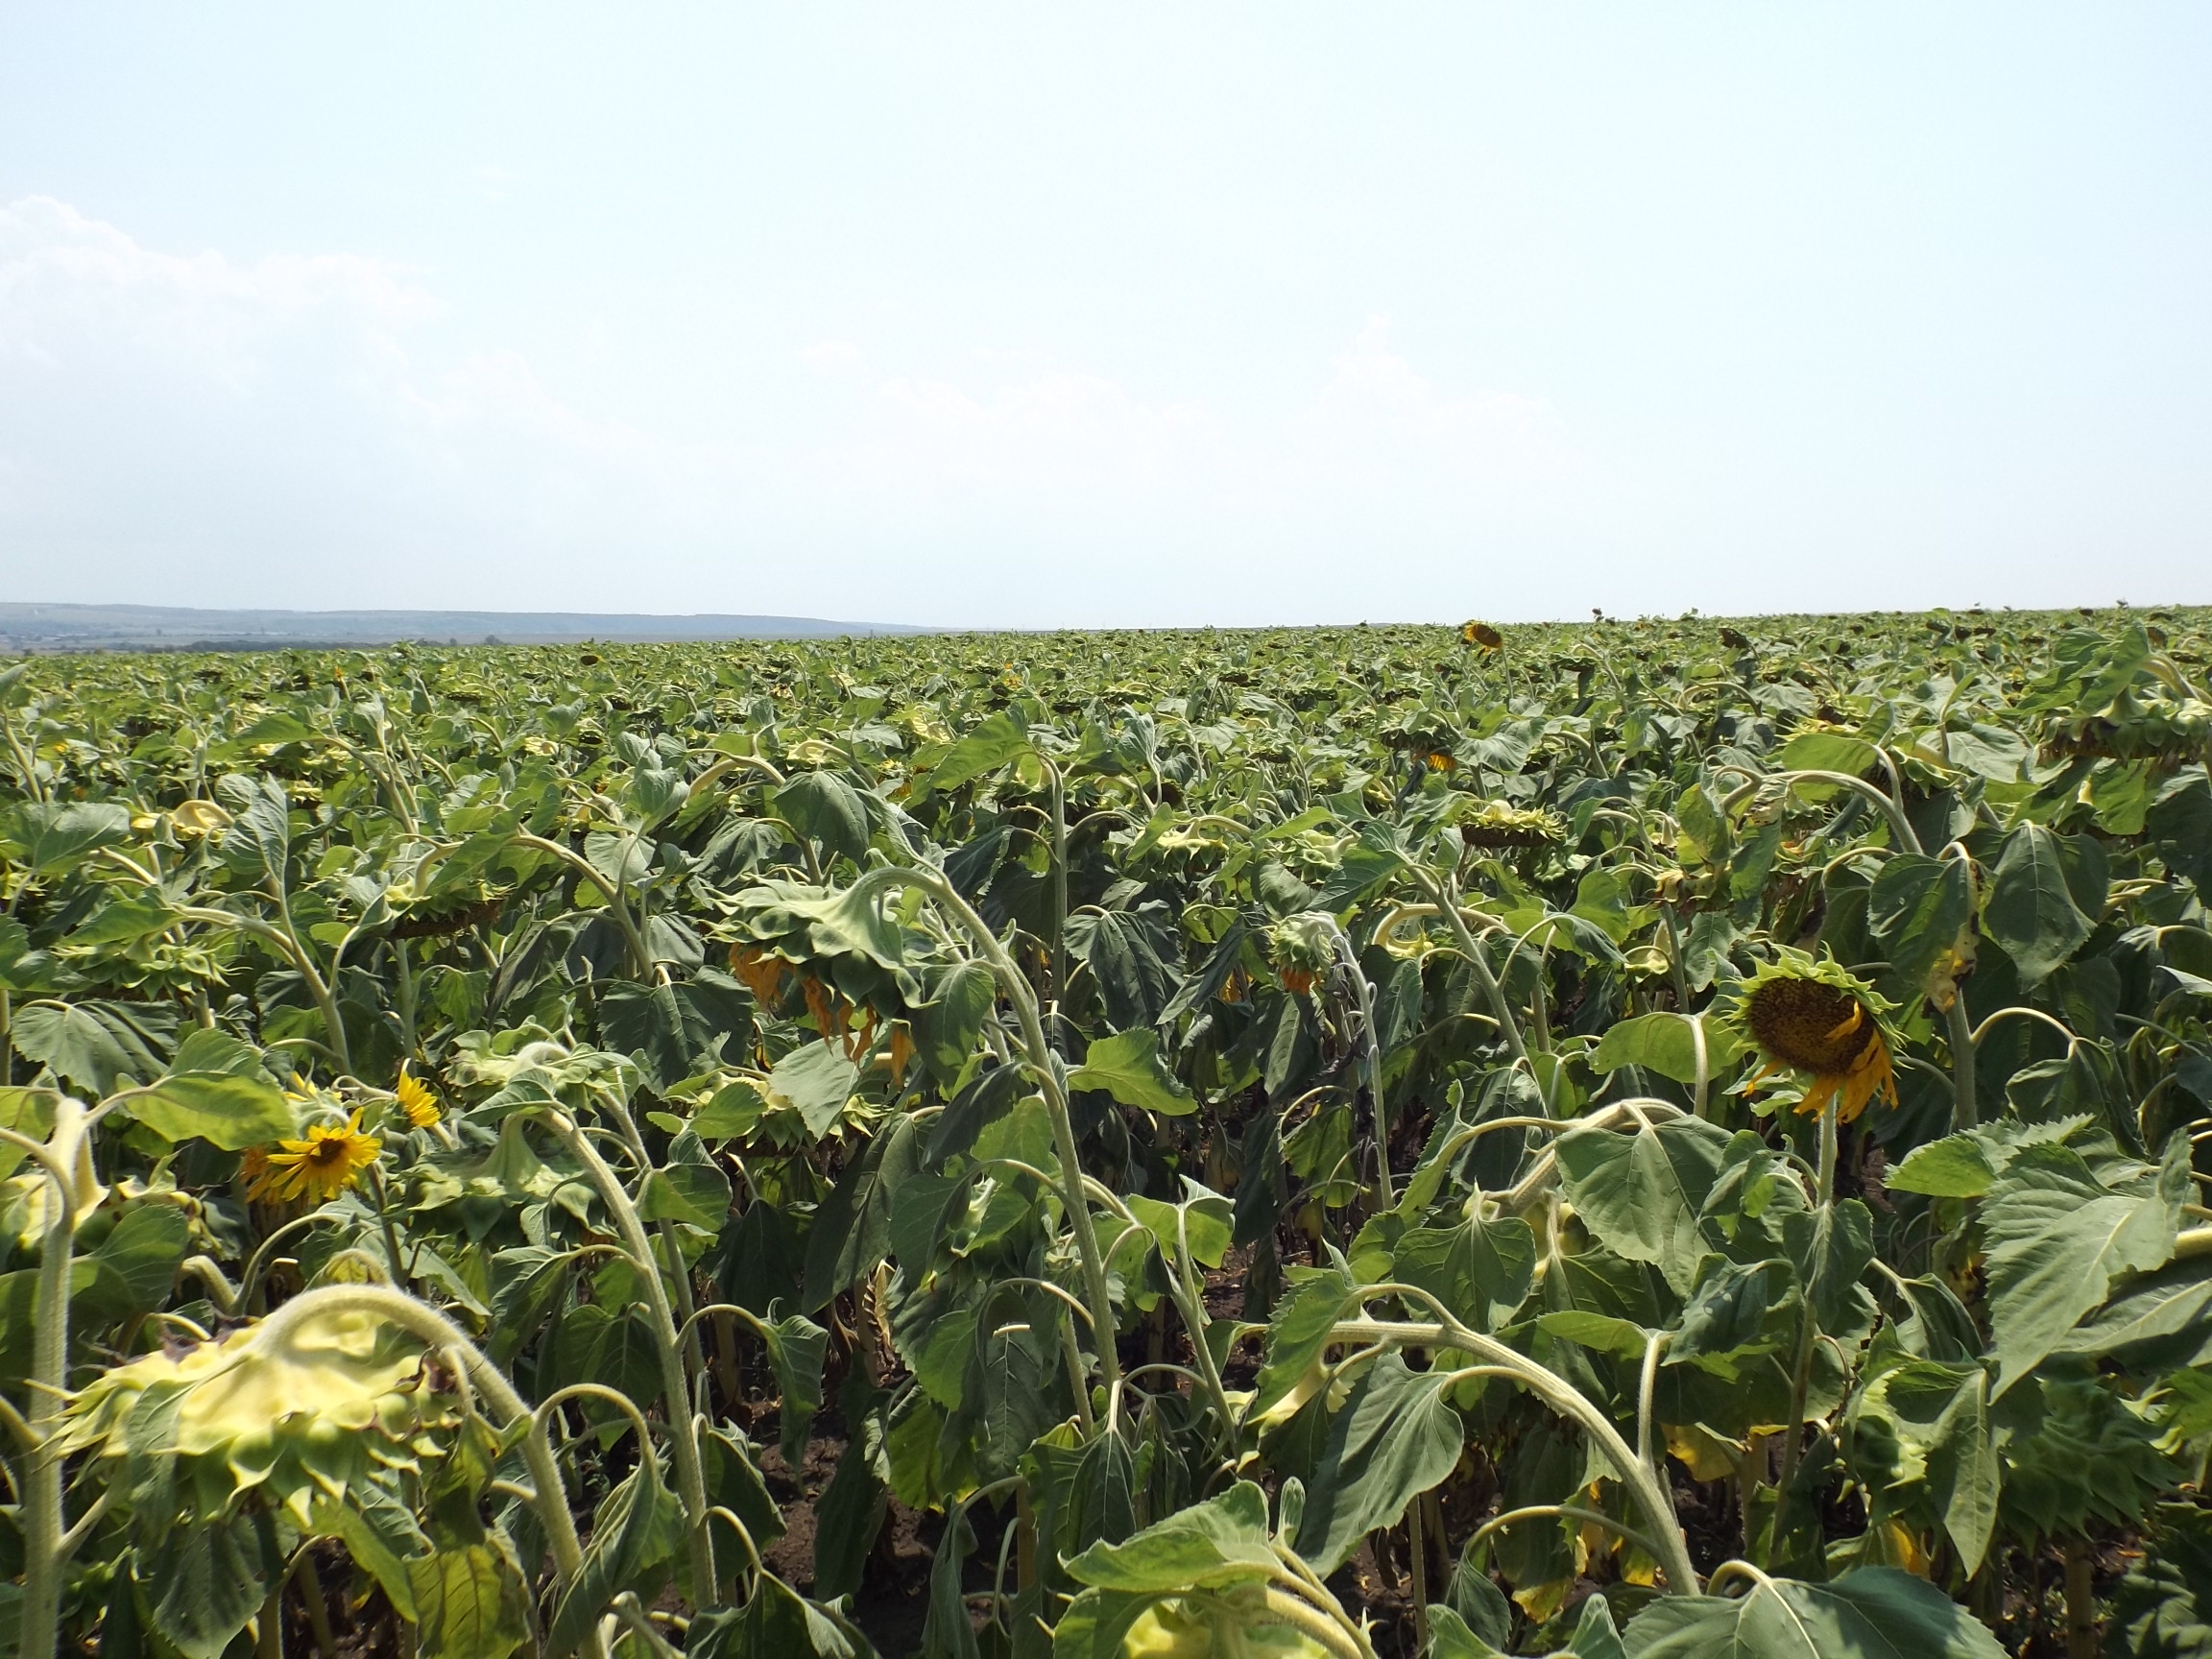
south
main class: Cropland
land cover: Sunflower
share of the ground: > 75 %
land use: Agriculture (excluding fallow land and kitchen gardens)
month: July
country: BG
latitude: 43.4931
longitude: 27.5054
